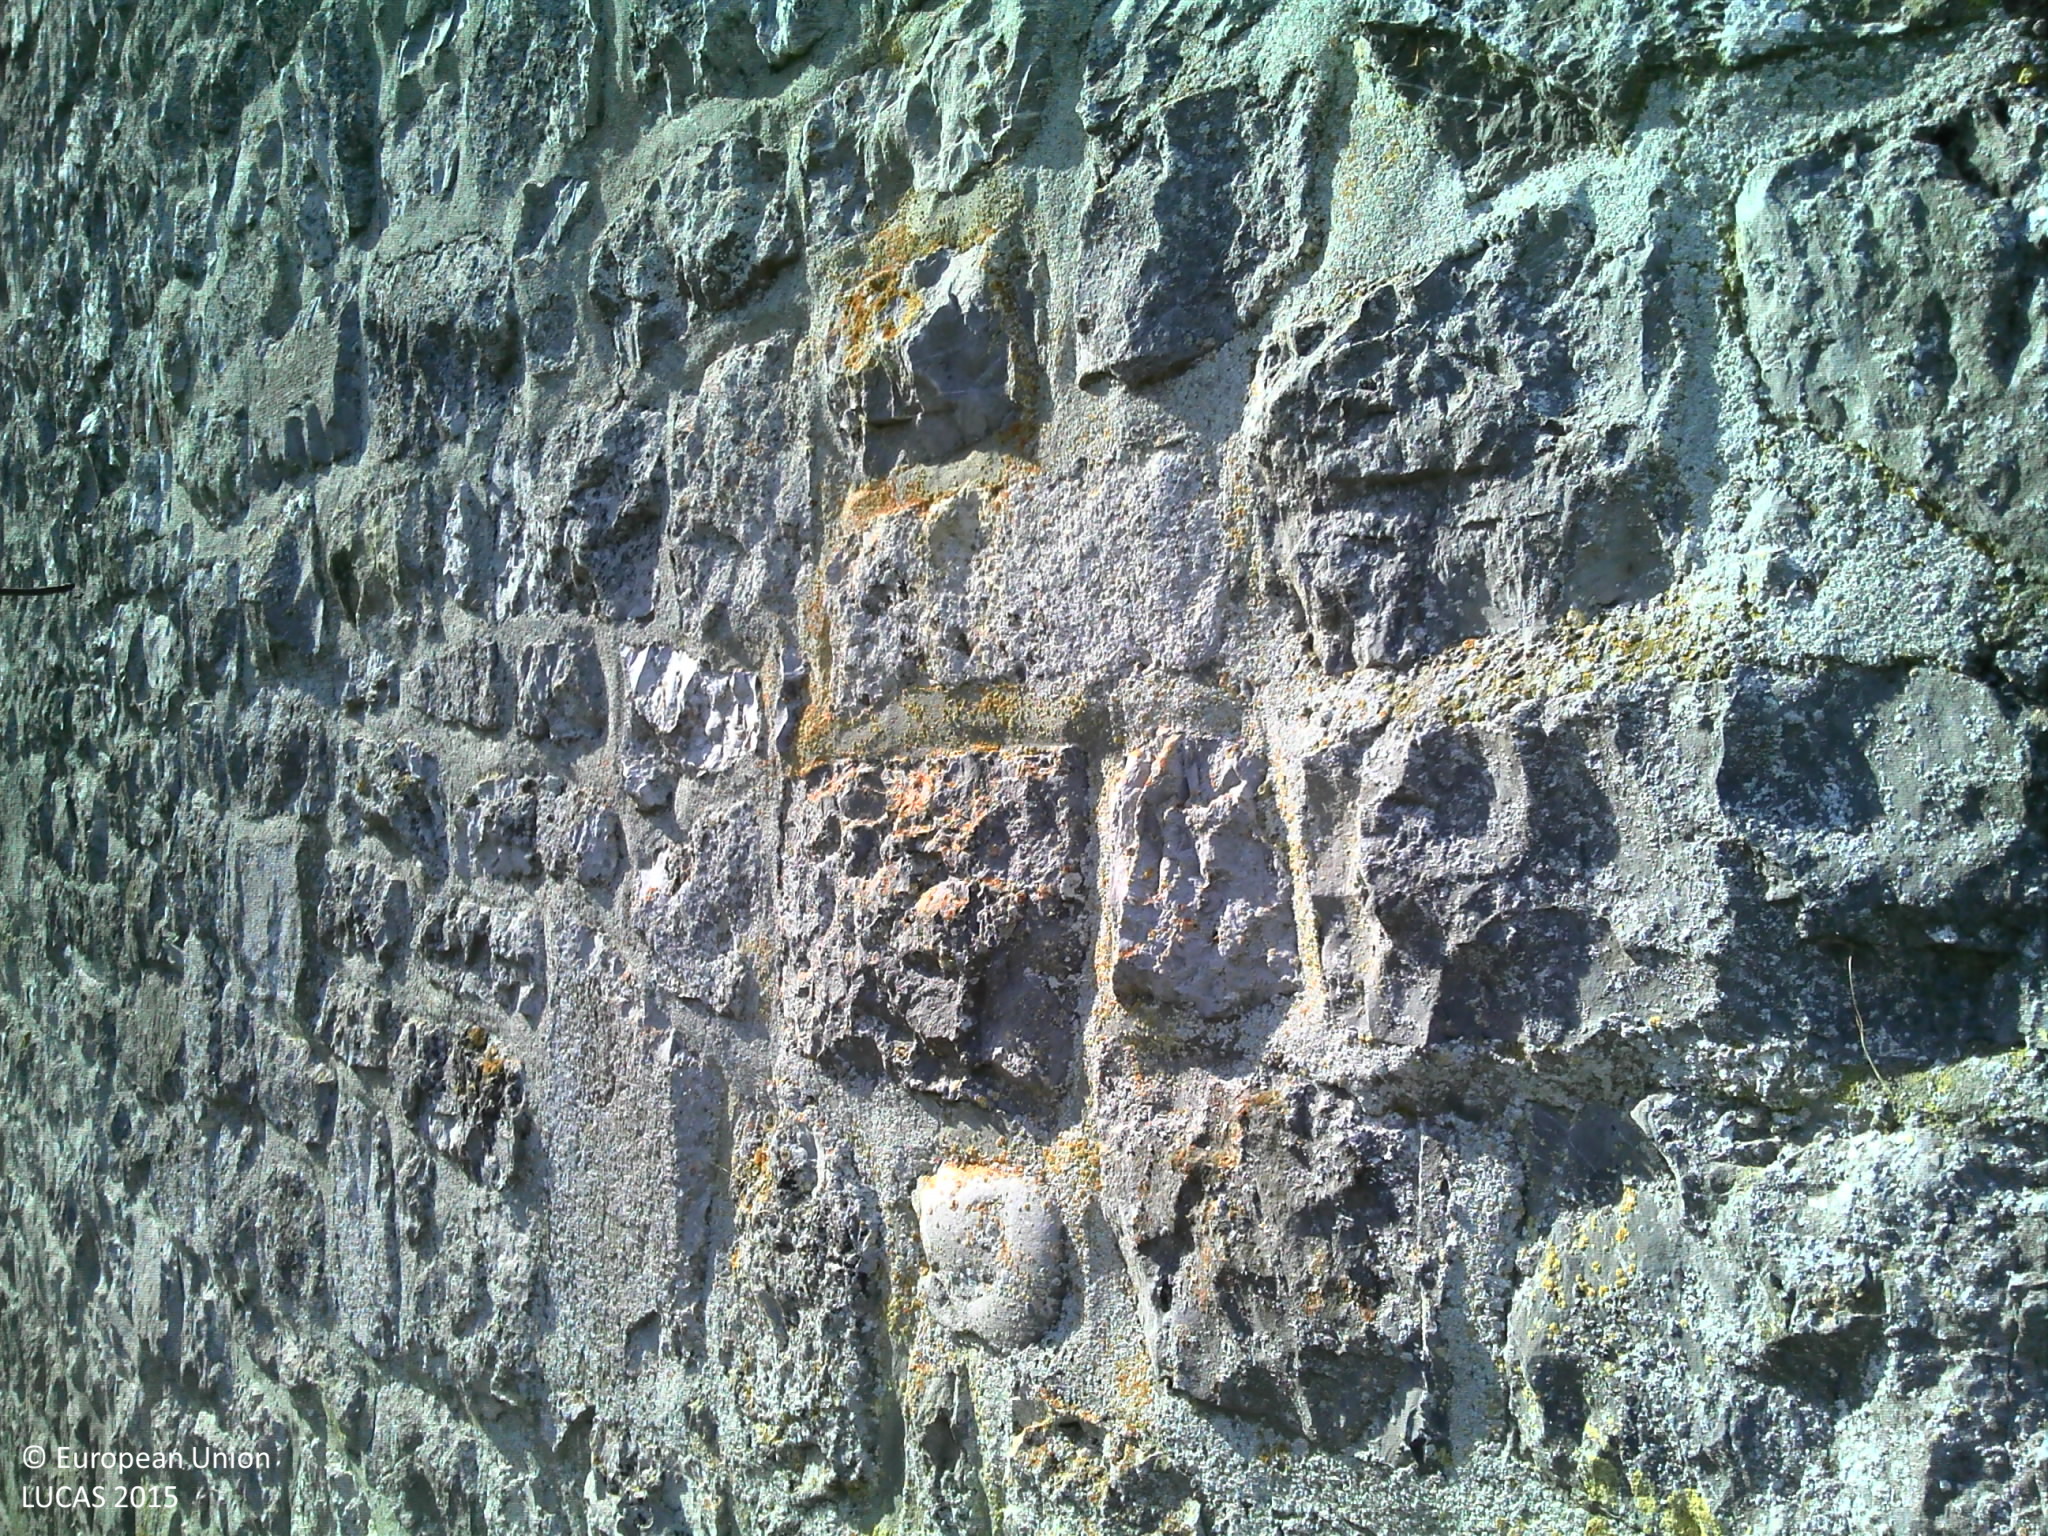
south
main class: Grassland
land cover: Grassland with sparse tree/shrub cover
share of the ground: > 75 %
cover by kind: herbaceous plants 95 %, broadleaved forest trees 5 %
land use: Residential
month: July
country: BE
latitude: 50.2916
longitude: 4.6203
